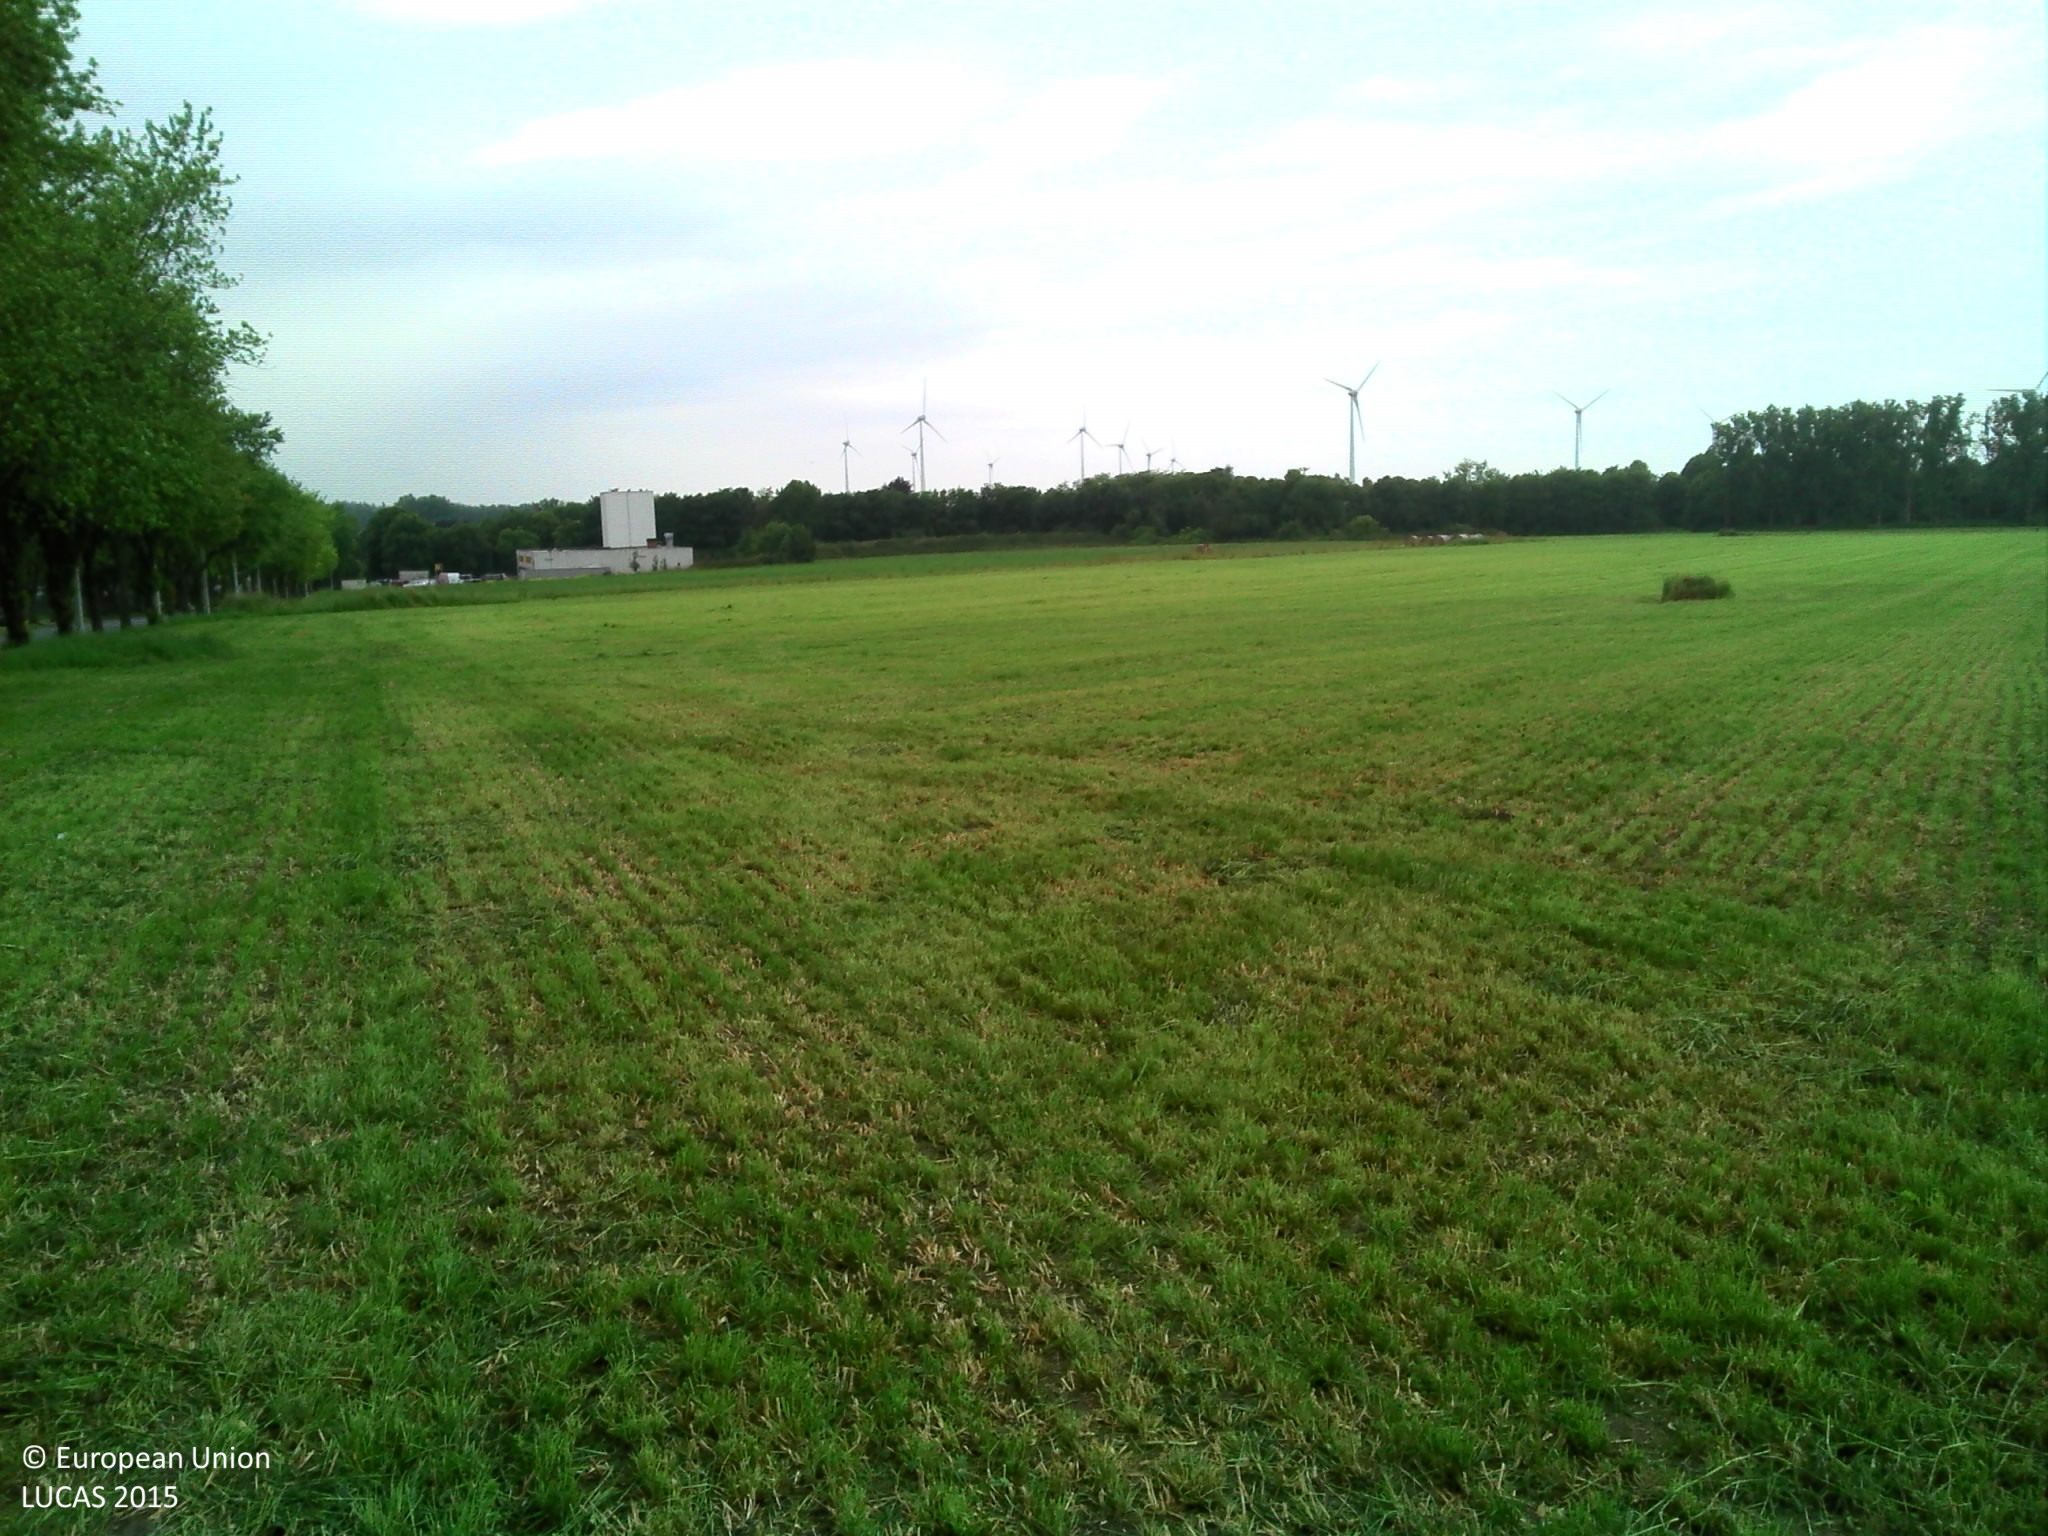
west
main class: Cropland
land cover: Temporary grasslands
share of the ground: > 75 %
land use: Agriculture (excluding fallow land and kitchen gardens)
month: June
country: BE
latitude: 50.4101
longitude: 3.7597
